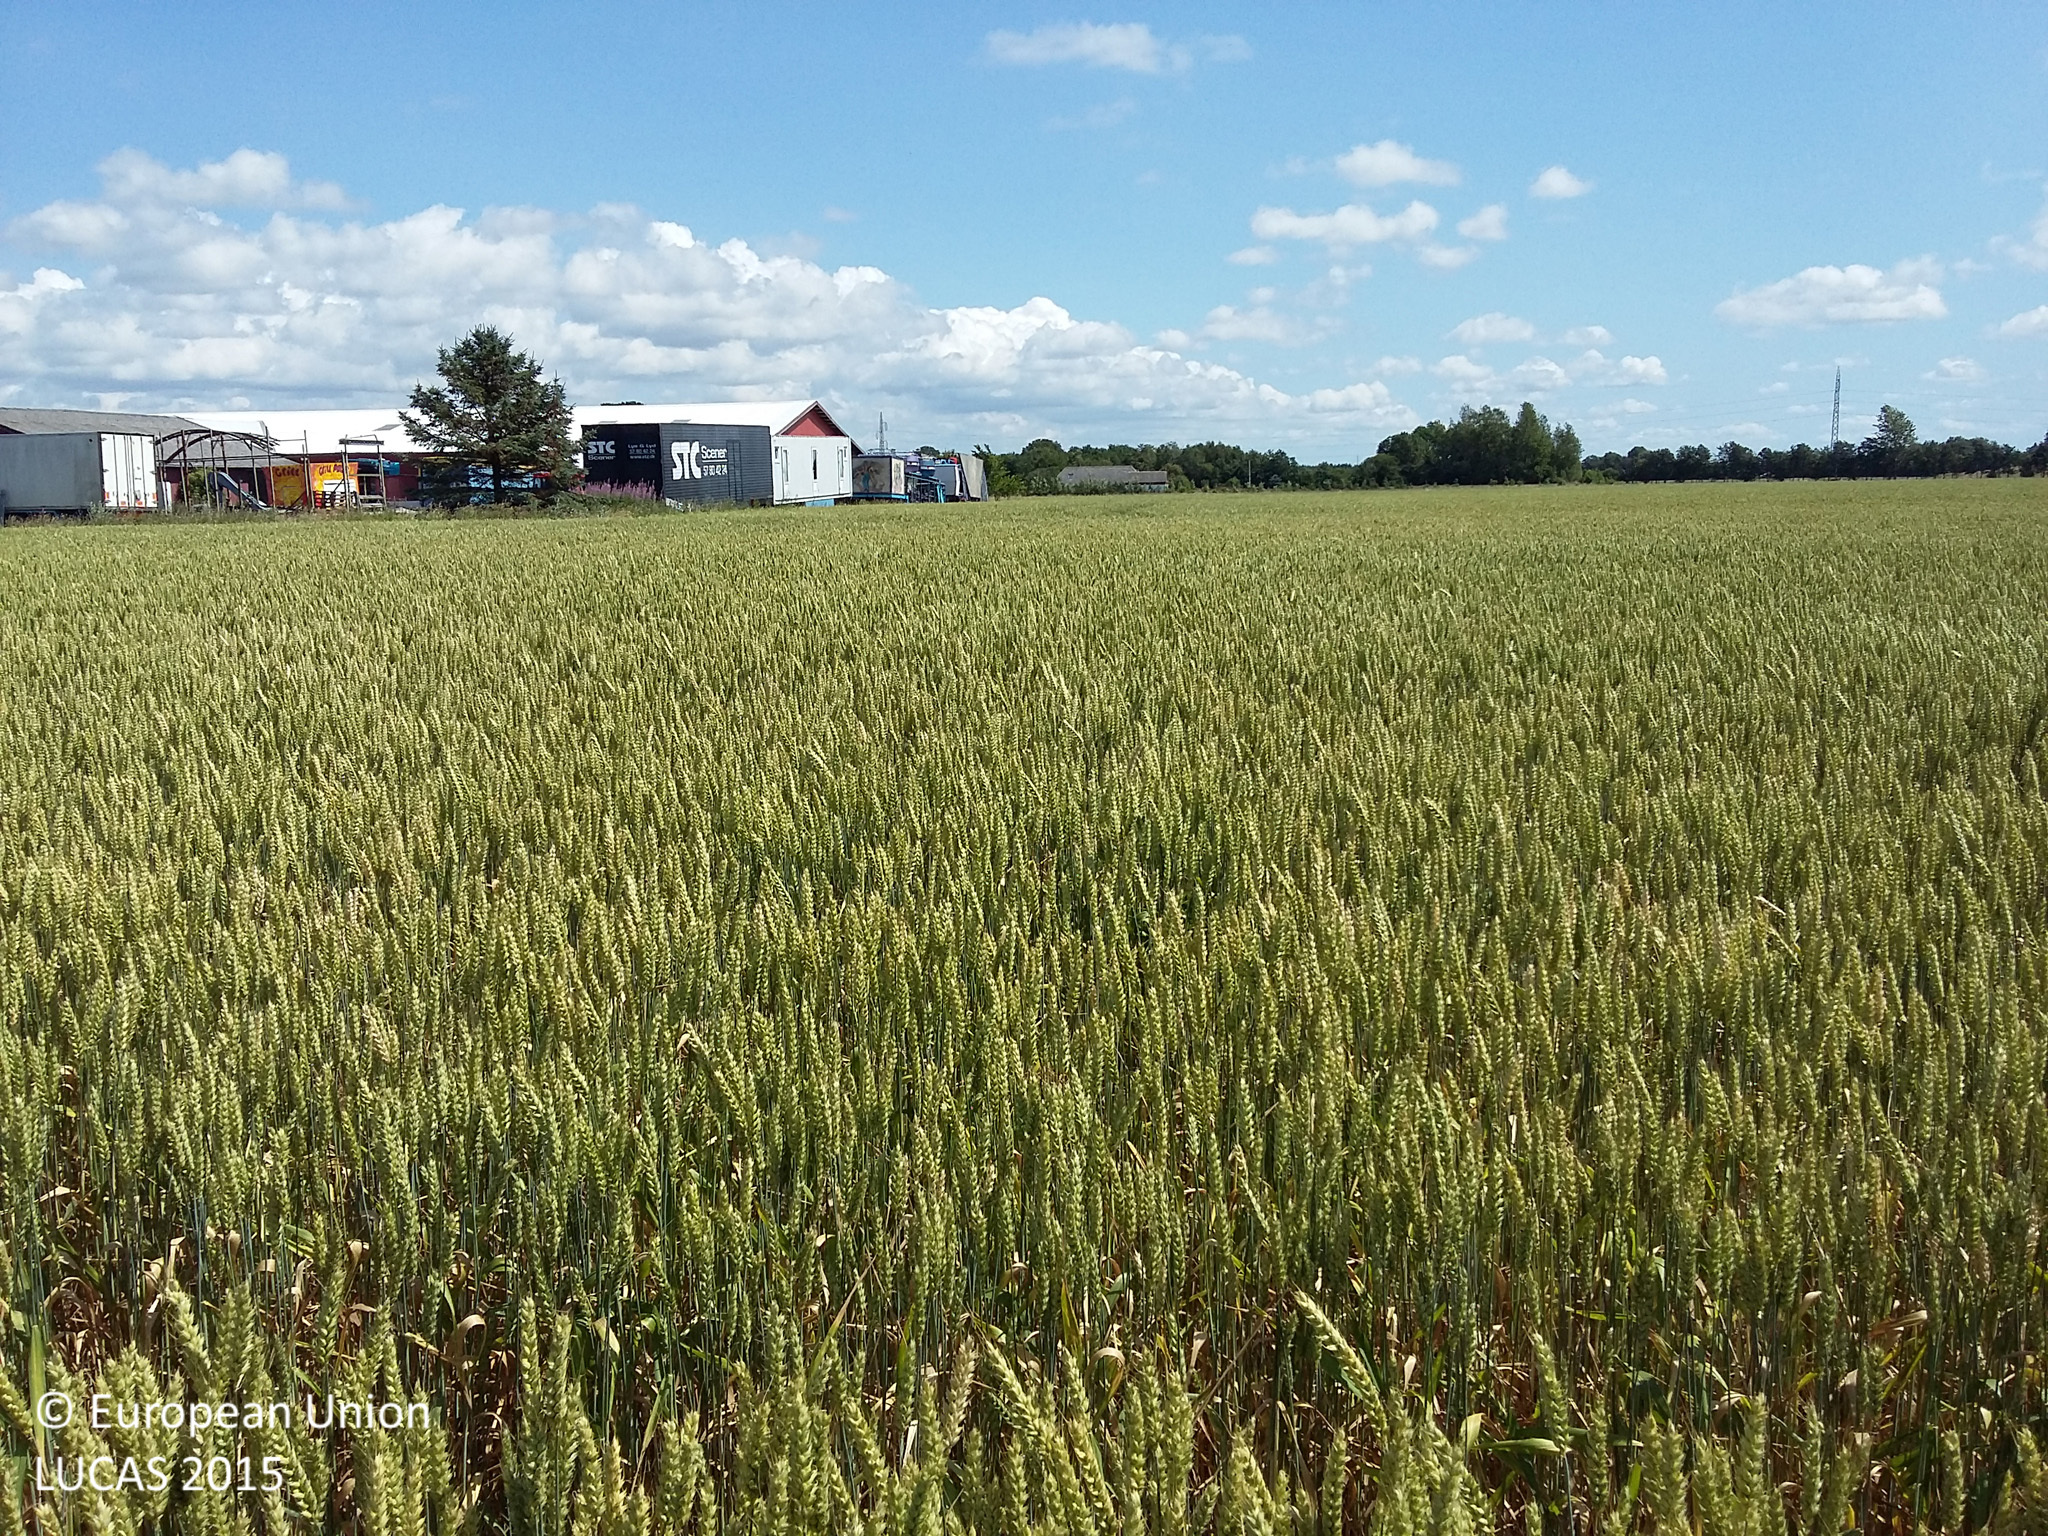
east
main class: Cropland
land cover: Common wheat
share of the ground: > 75 %
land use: Agriculture (excluding fallow land and kitchen gardens)
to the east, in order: Common wheat; Artificial constructions in urban areas; Common wheat; Shruby margins; Common wheat
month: July
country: DK
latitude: 55.5138
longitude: 11.5031
